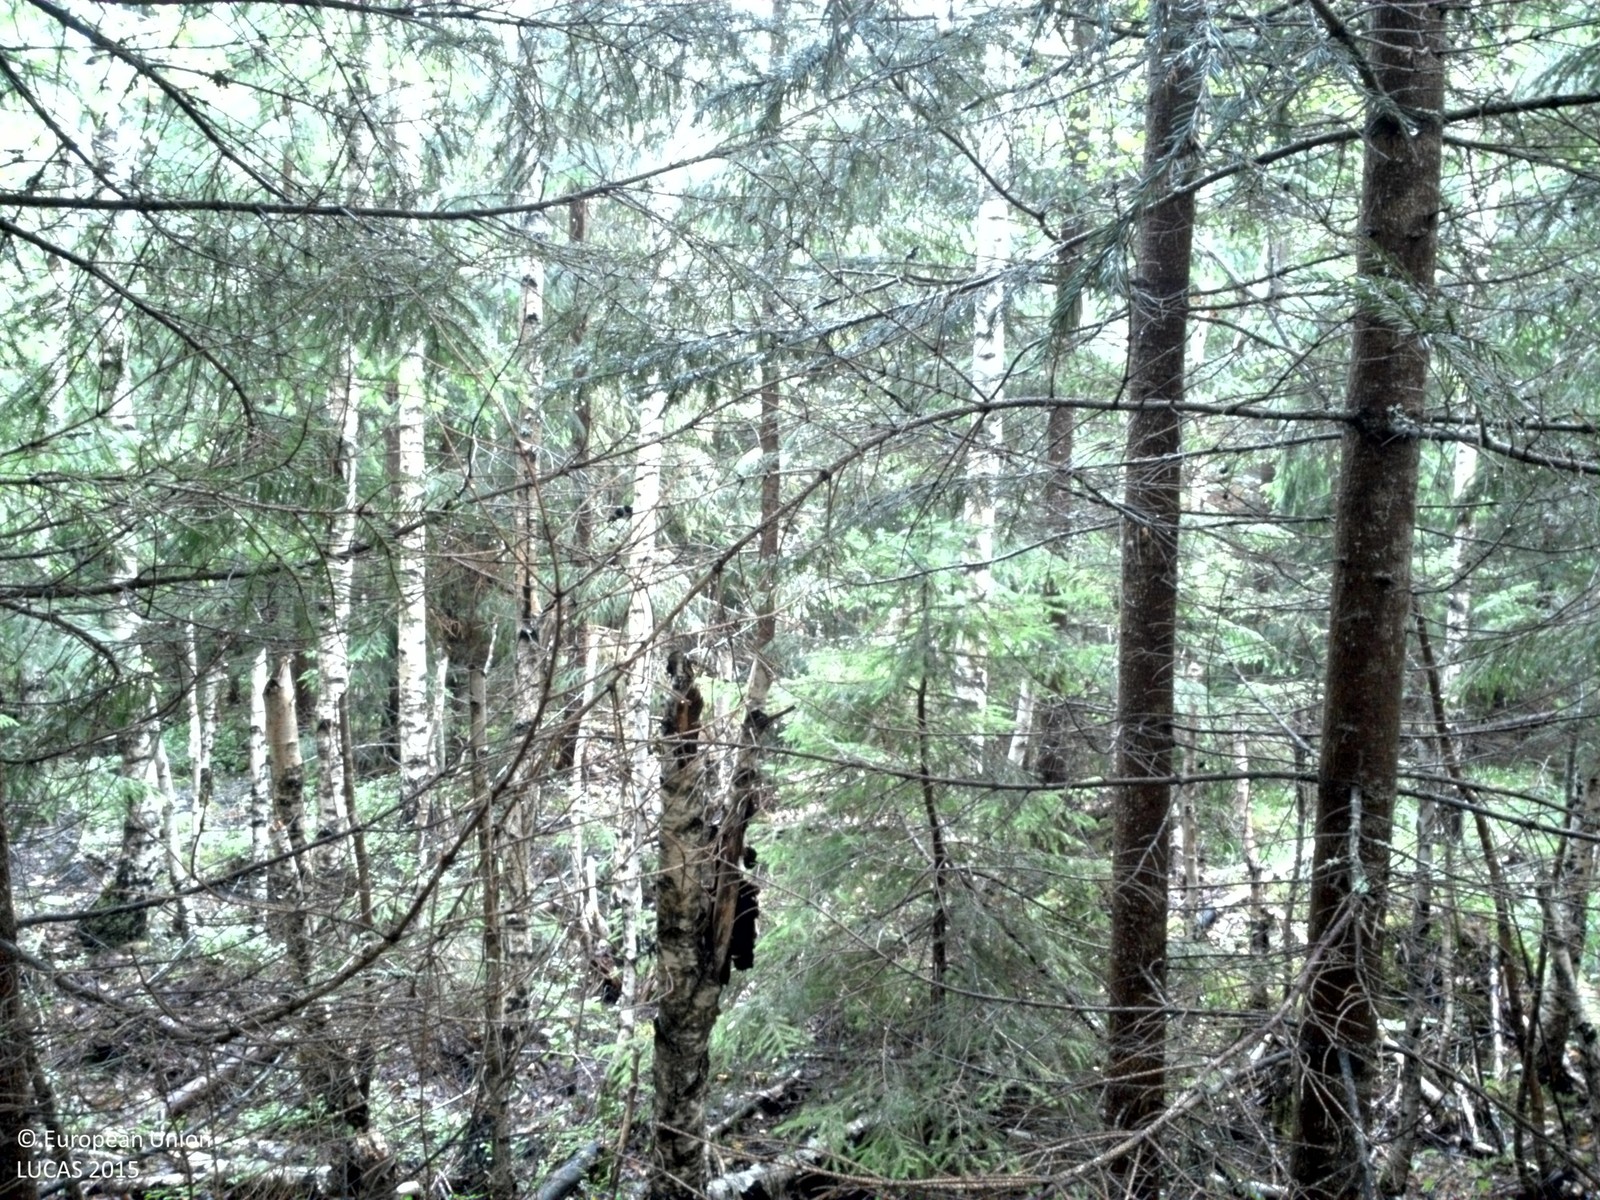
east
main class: Woodland
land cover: Spruce dominated coniferous woodland
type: boreal forest
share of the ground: > 75 %
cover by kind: coniferous forest trees 65 %, lichens and mosses 20 %, broadleaved forest trees 10 %, herbaceous plants 5 %
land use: Forestry
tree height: > 5 m
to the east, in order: Spruce dominated coniferous woodland; Grassland without tree/shrub cover; Groves; Ditches and canals; Grassland without tree/shrub cover
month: July
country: SE
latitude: 59.8955
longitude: 18.6679
